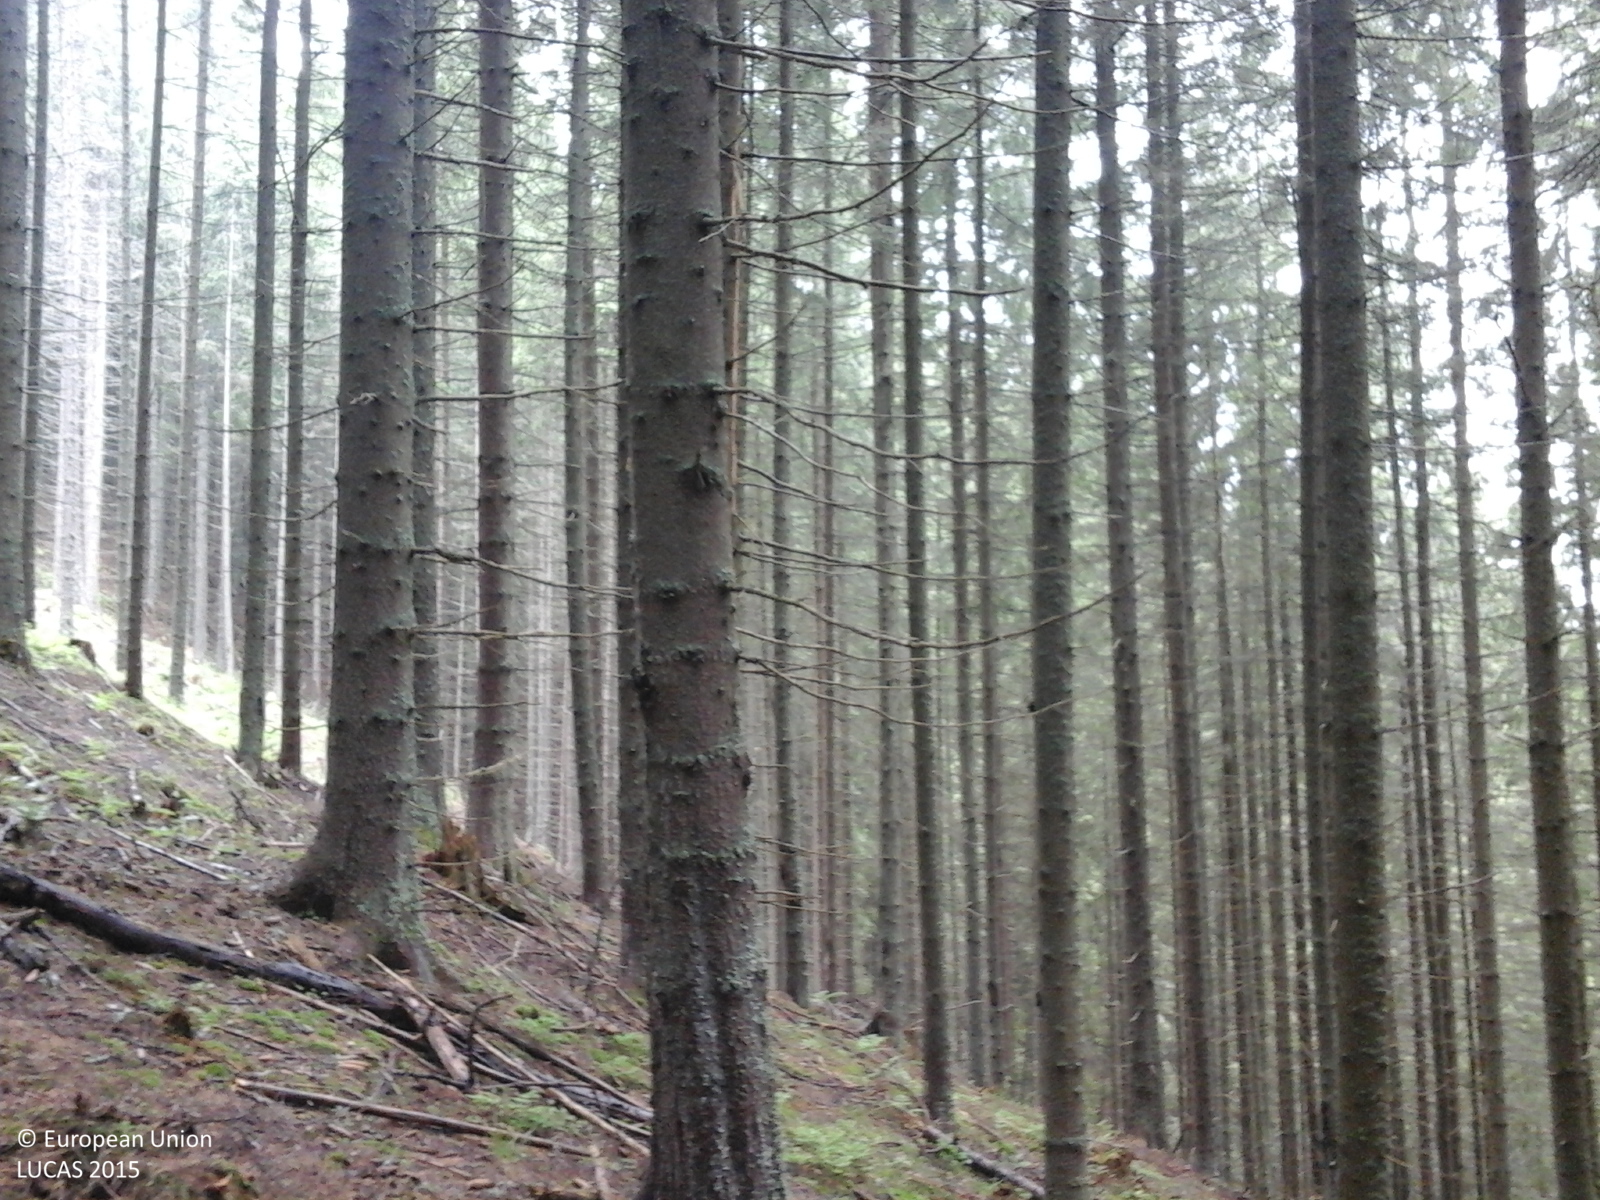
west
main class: Woodland
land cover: Spruce dominated coniferous woodland
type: alpine coniferous forest
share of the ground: > 75 %
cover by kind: coniferous forest trees 100 %
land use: Forestry
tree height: > 5 m
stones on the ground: < 10 %
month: June
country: RO
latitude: 47.6481
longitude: 25.3838
